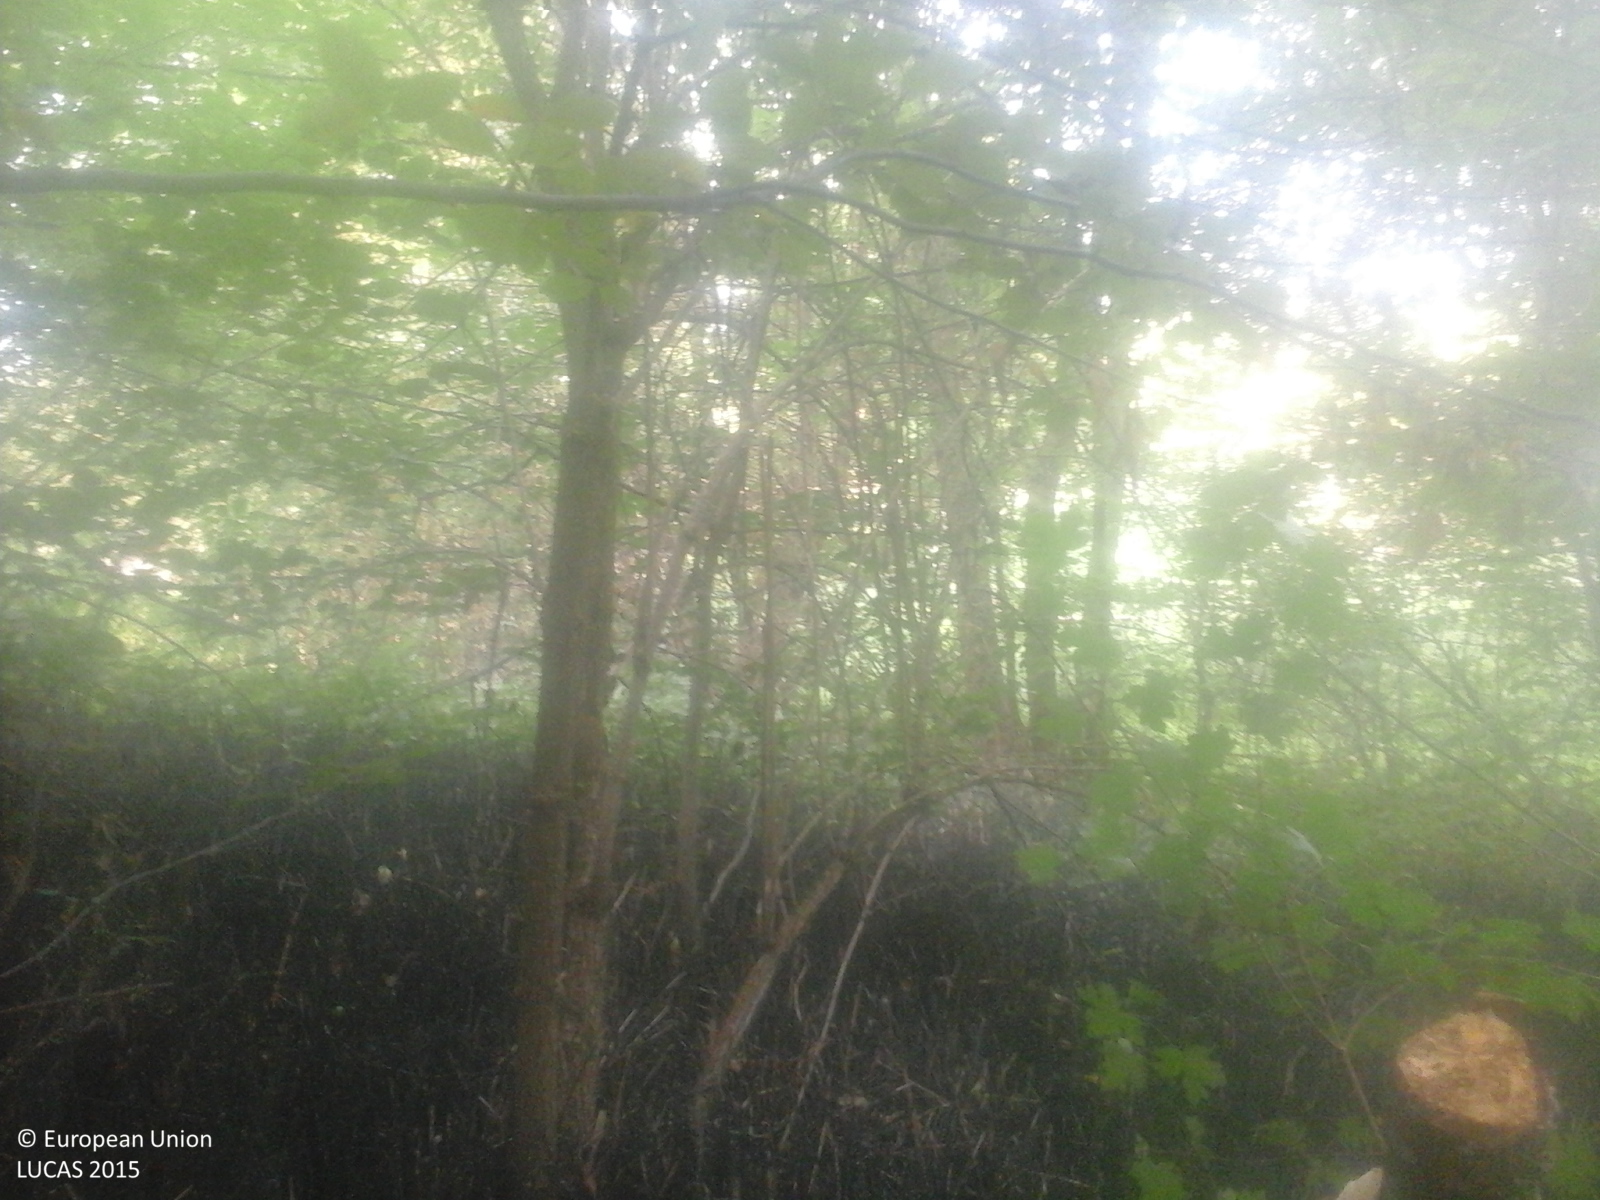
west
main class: Woodland
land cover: Broadleaved woodland
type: beech forest
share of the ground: > 75 %
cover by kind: broadleaved forest trees 100 %
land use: Forestry
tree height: > 5 m
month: September
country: RO
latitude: 46.0689
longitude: 22.8141
